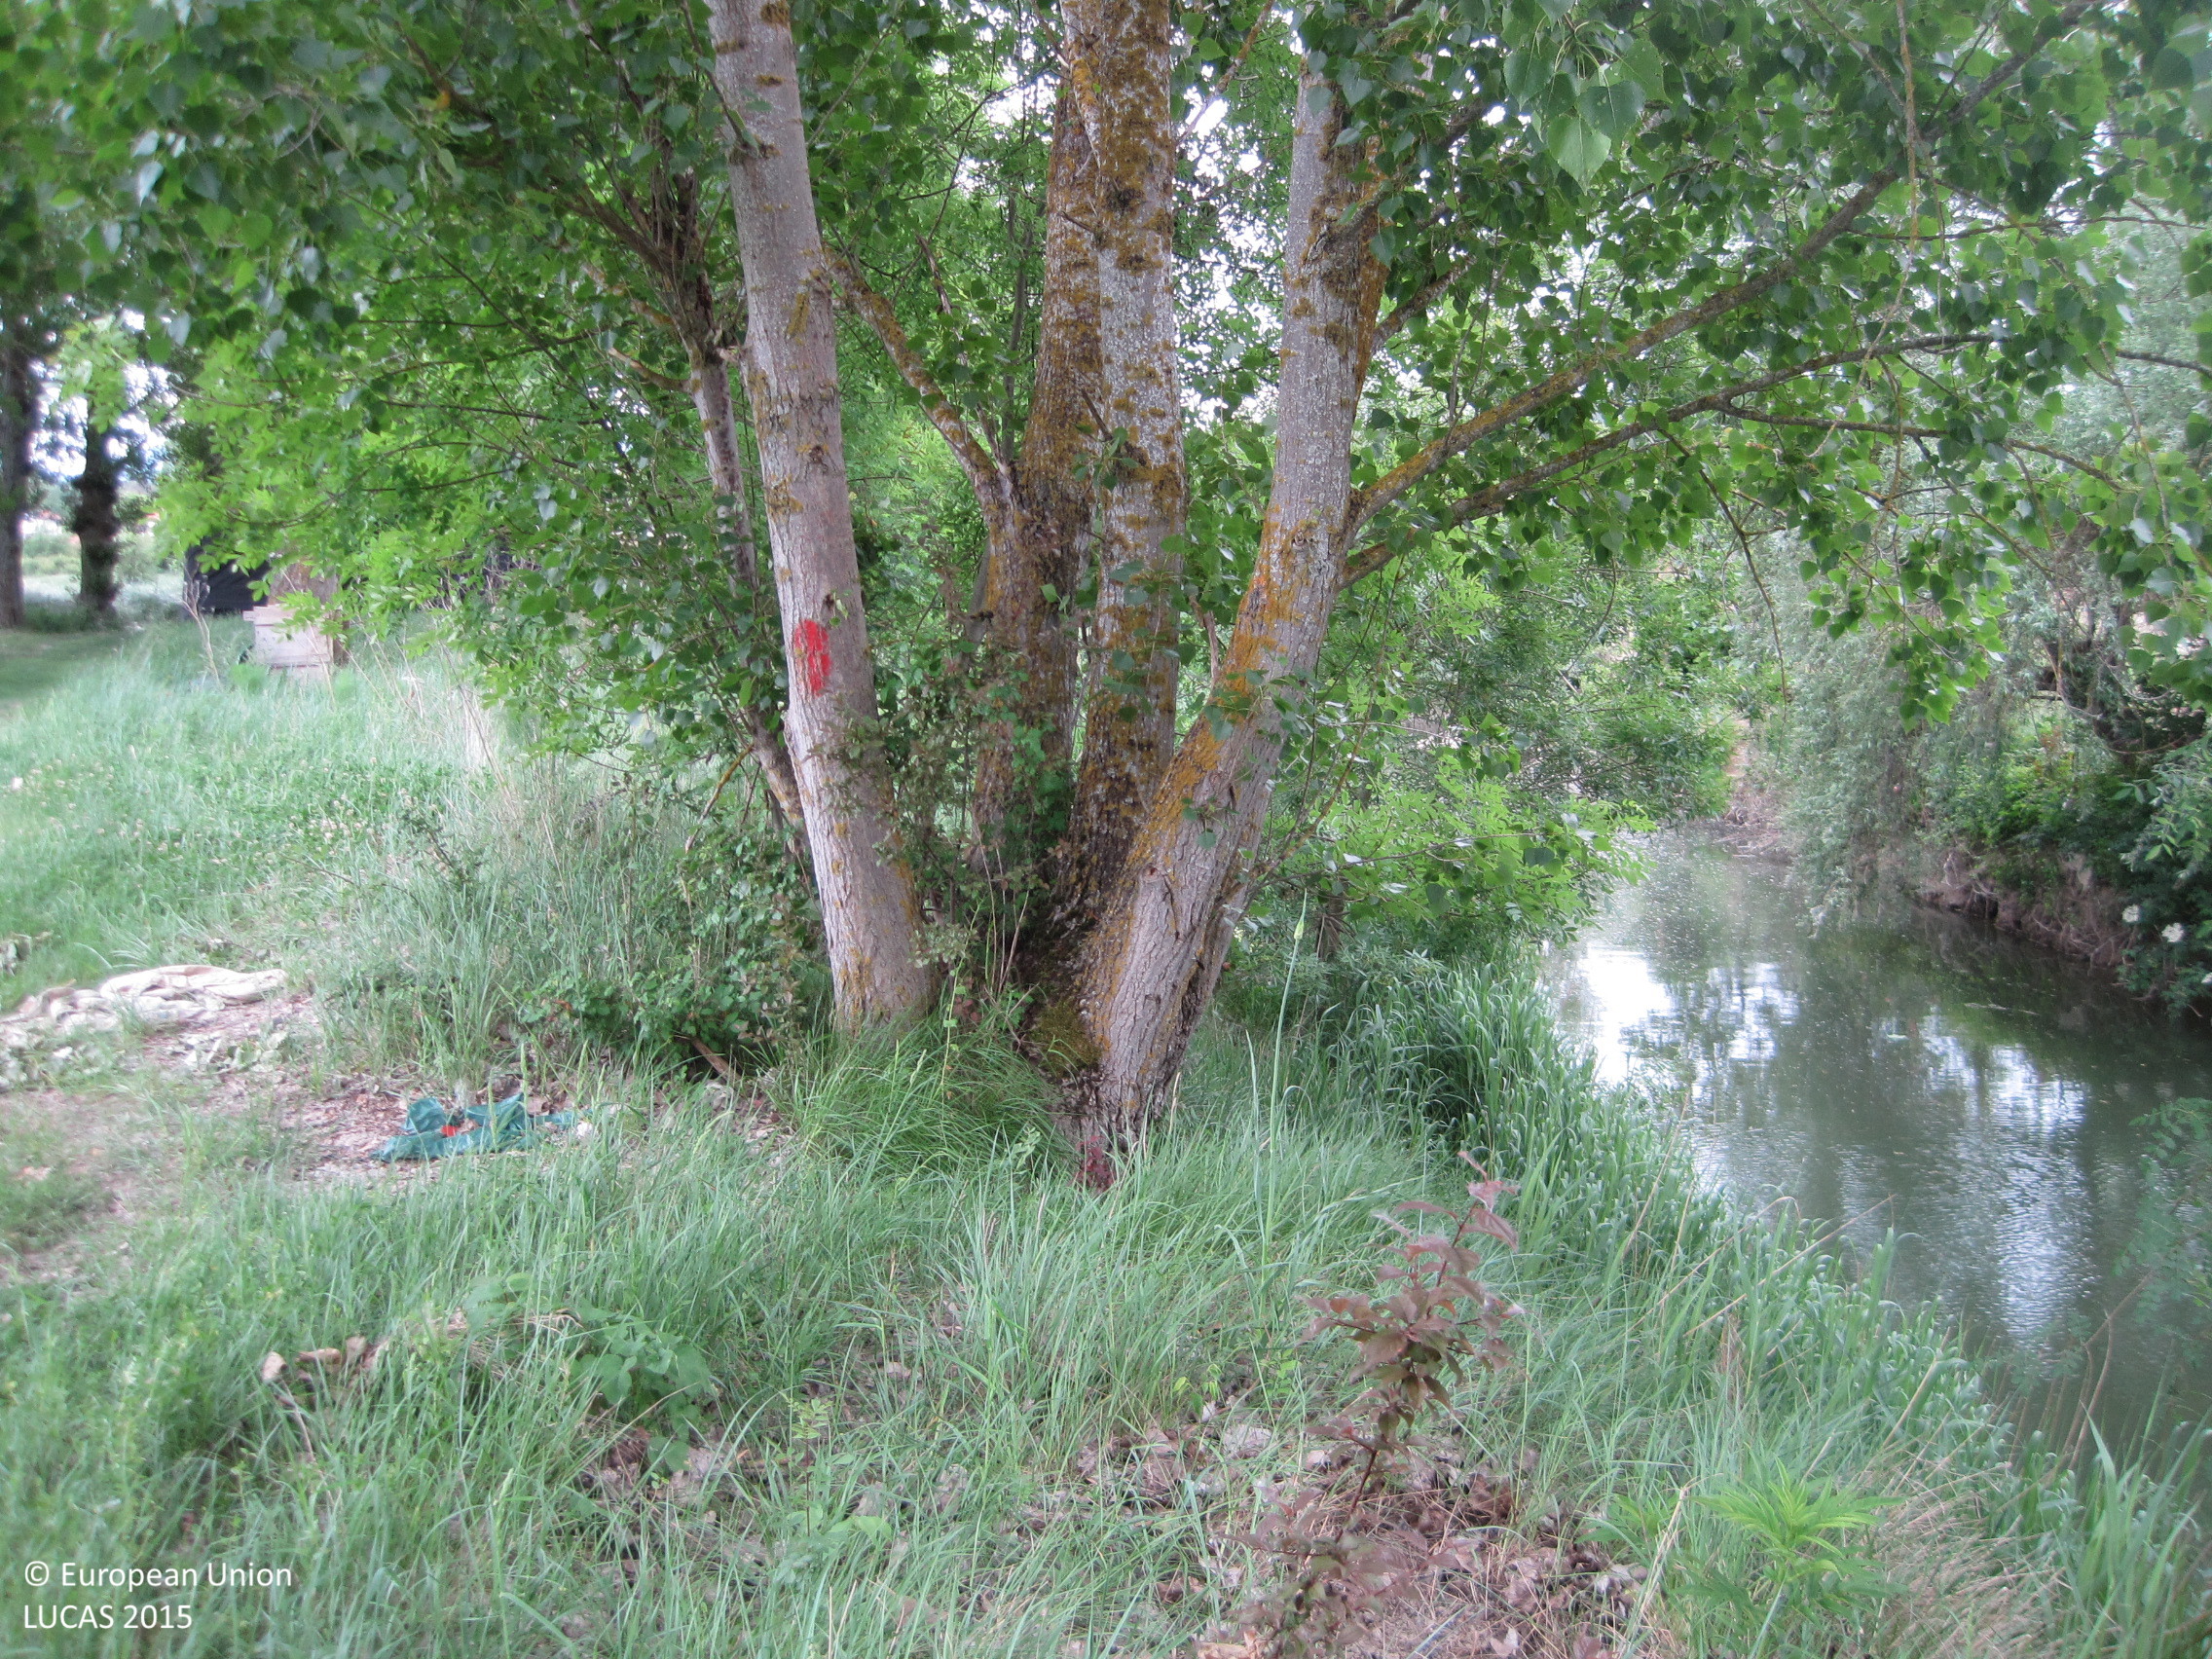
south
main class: Woodland
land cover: Broadleaved woodland
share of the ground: > 75 %
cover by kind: broadleaved forest trees 100 %
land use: Semi-natural and natural areas not in use
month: May
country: ES
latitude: 42.7975
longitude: -1.6667
